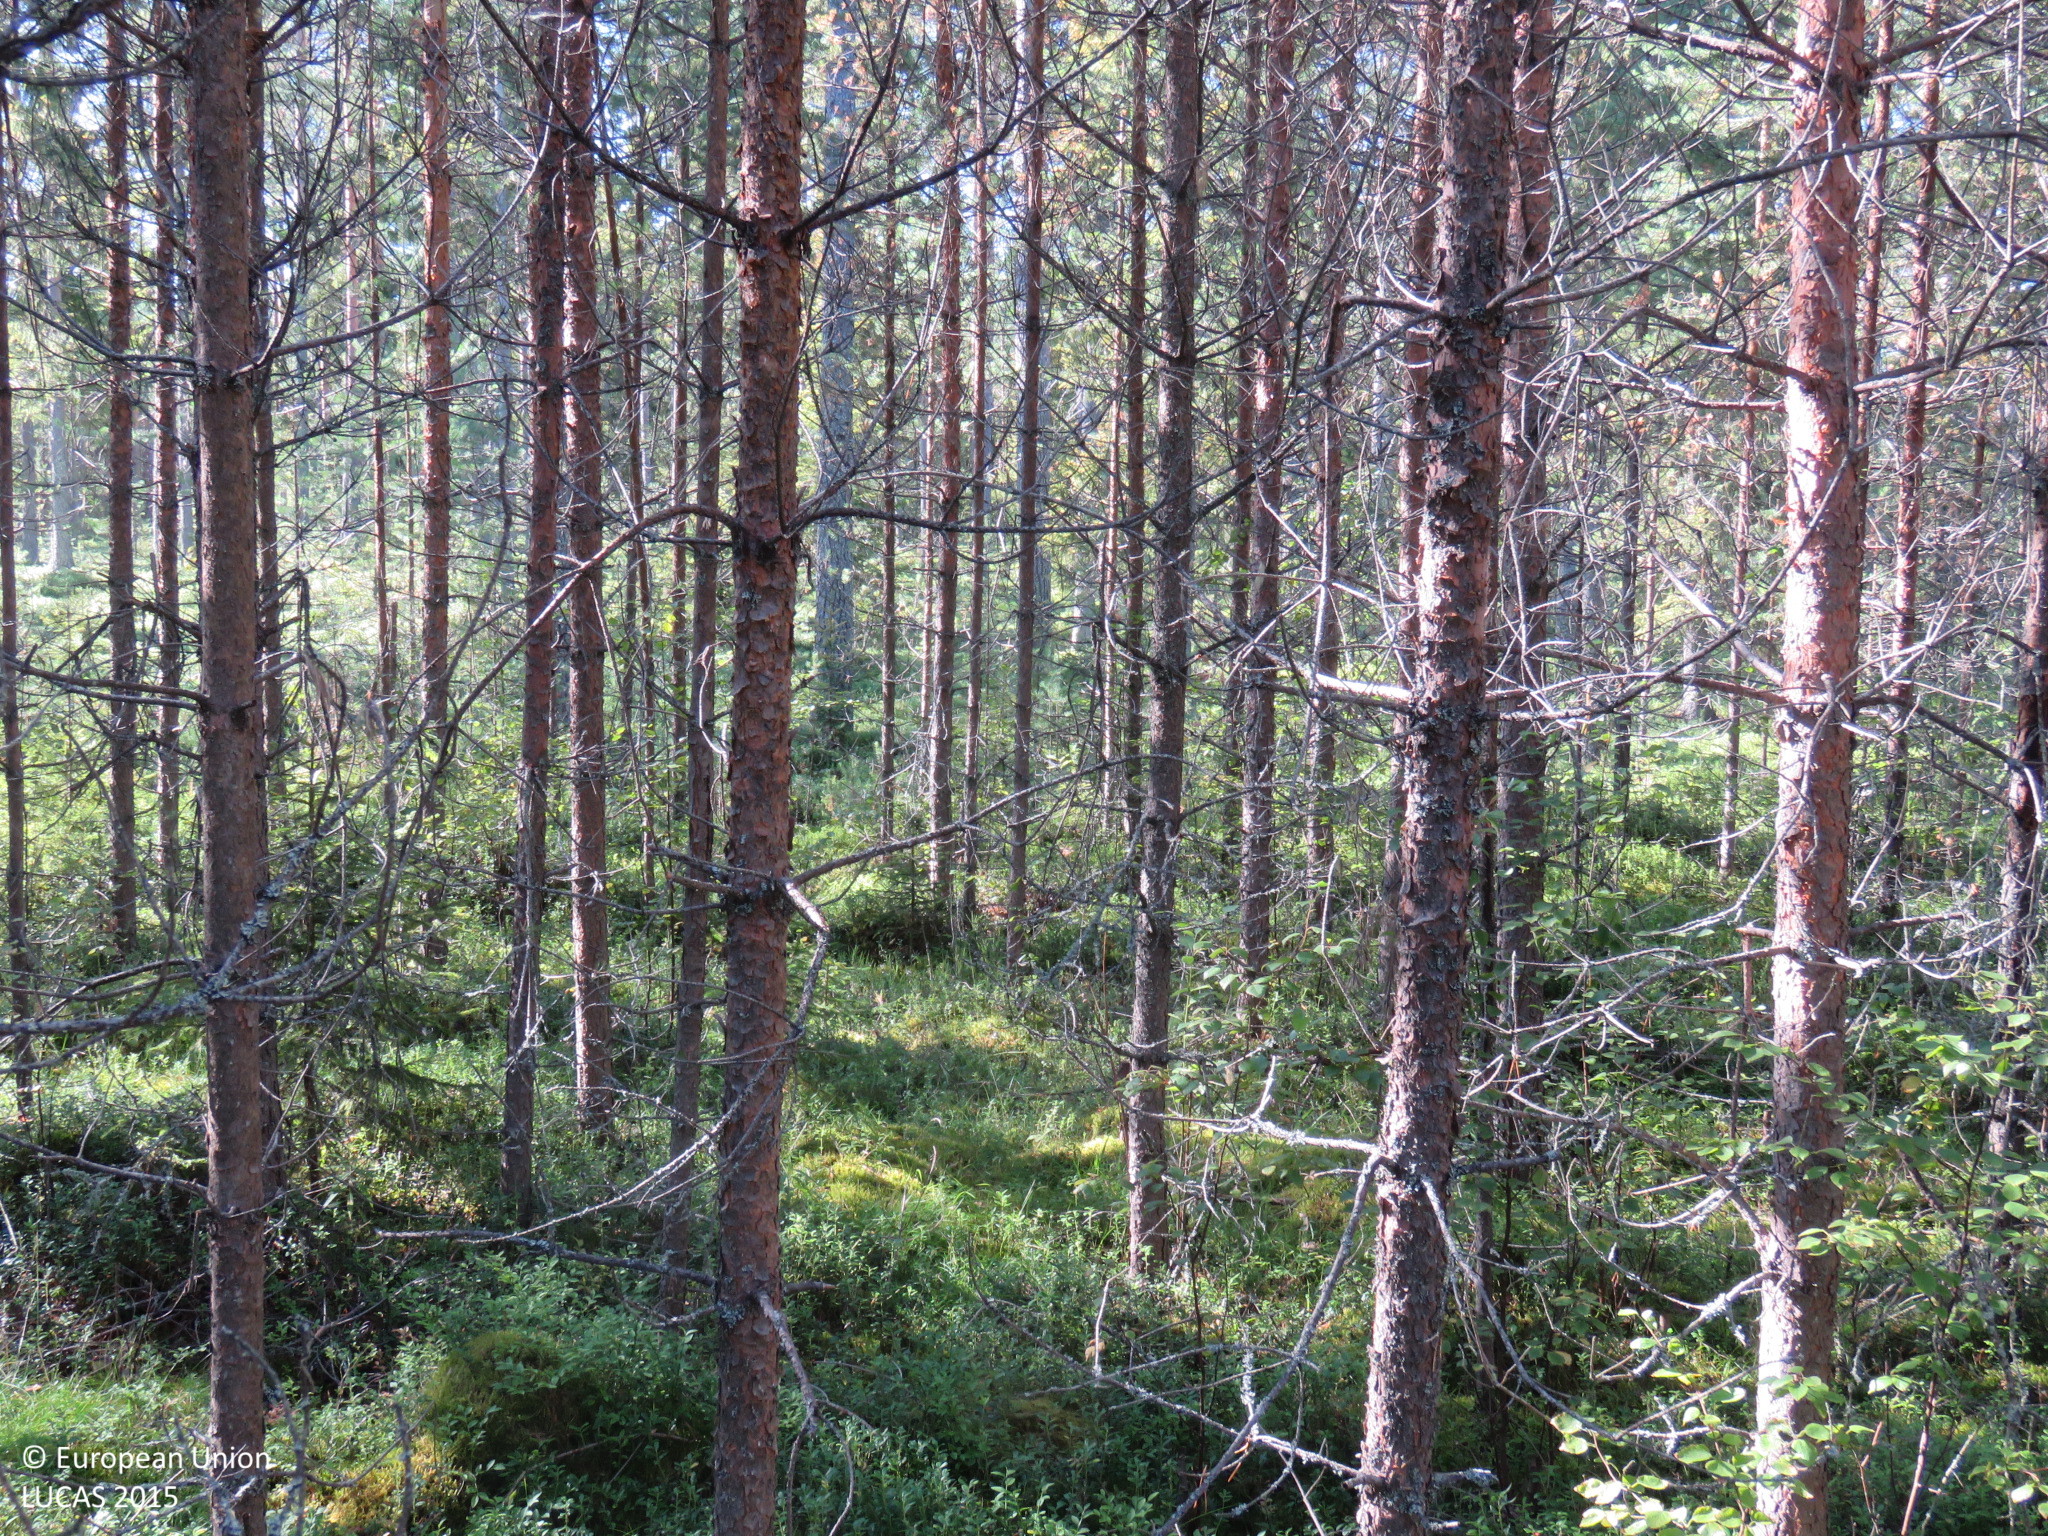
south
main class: Woodland
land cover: Pine dominated coniferous woodland
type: boreal forest
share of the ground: > 75 %
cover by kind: coniferous forest trees 85 %, broadleaved forest trees 5 %, shrubs 5 %, lichens and mosses 5 %
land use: Forestry
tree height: > 5 m
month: August
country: FI
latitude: 65.1560
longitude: 25.5916
